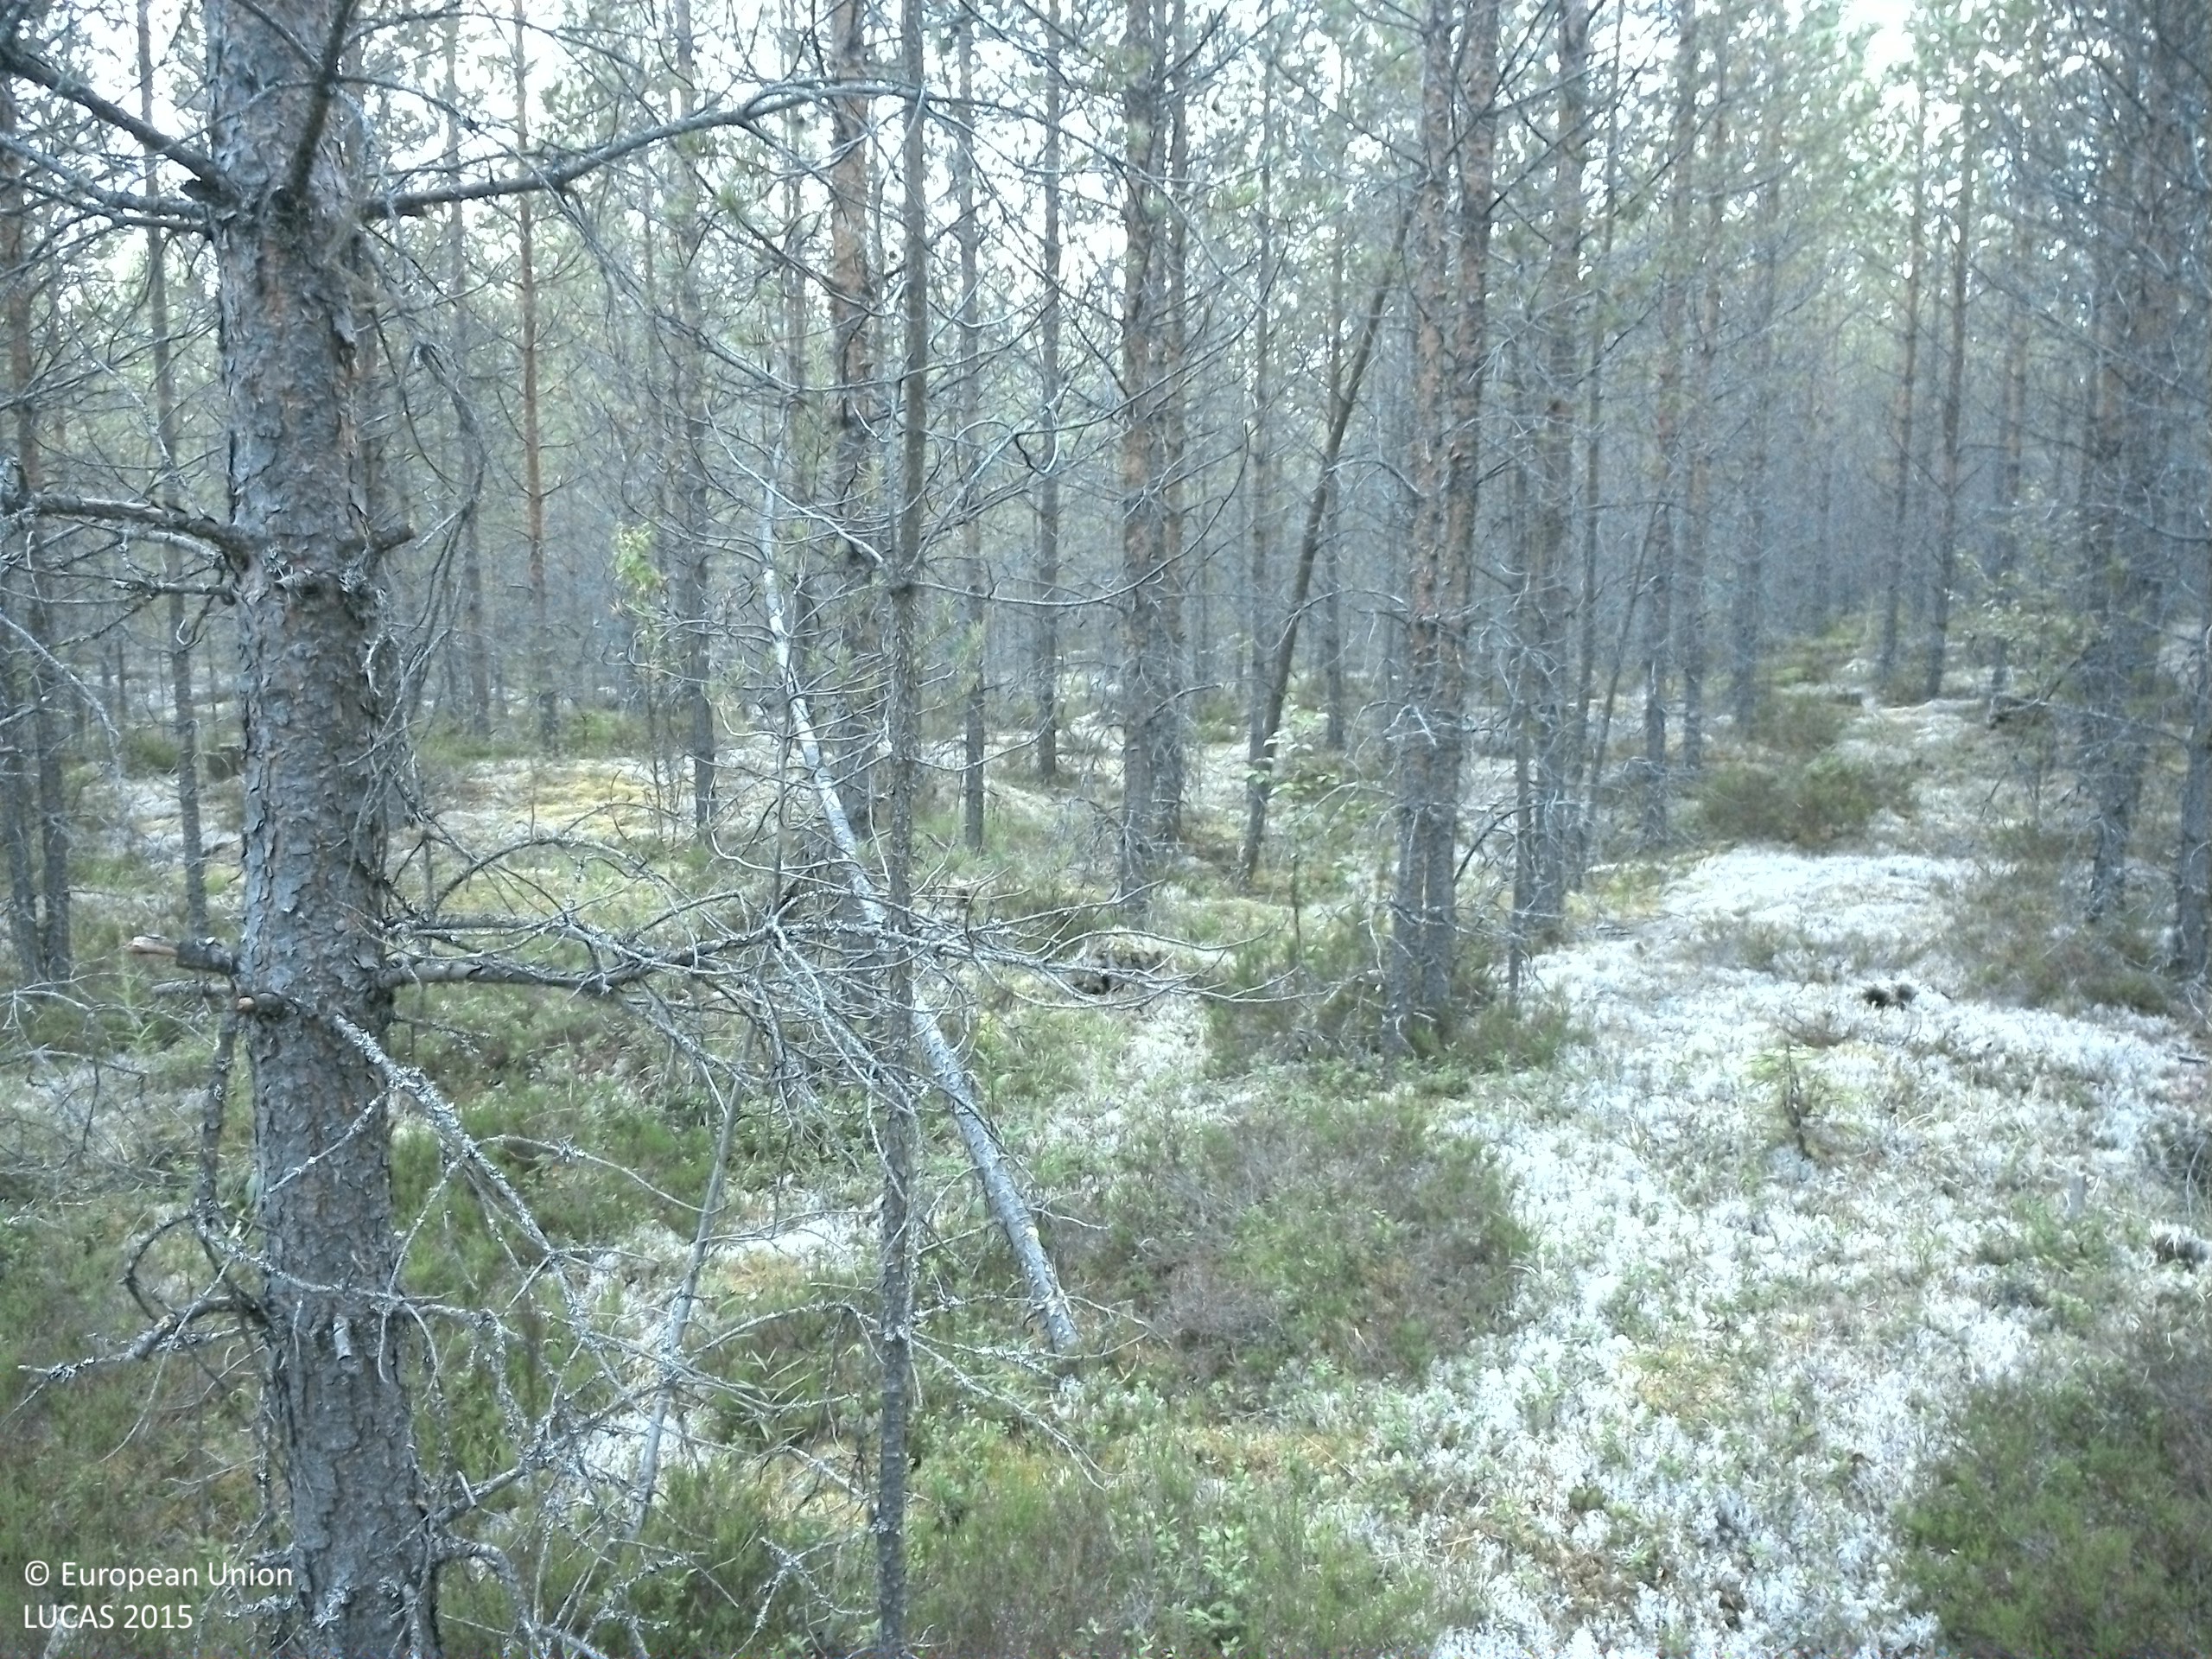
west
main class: Woodland
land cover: Pine dominated coniferous woodland
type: boreal forest
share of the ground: 25 - 50 %
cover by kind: lichens and mosses 45 %, coniferous forest trees 35 %, shrubs 20 %
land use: Forestry
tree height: > 5 m
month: August
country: SE
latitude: 63.6720
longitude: 16.3793
